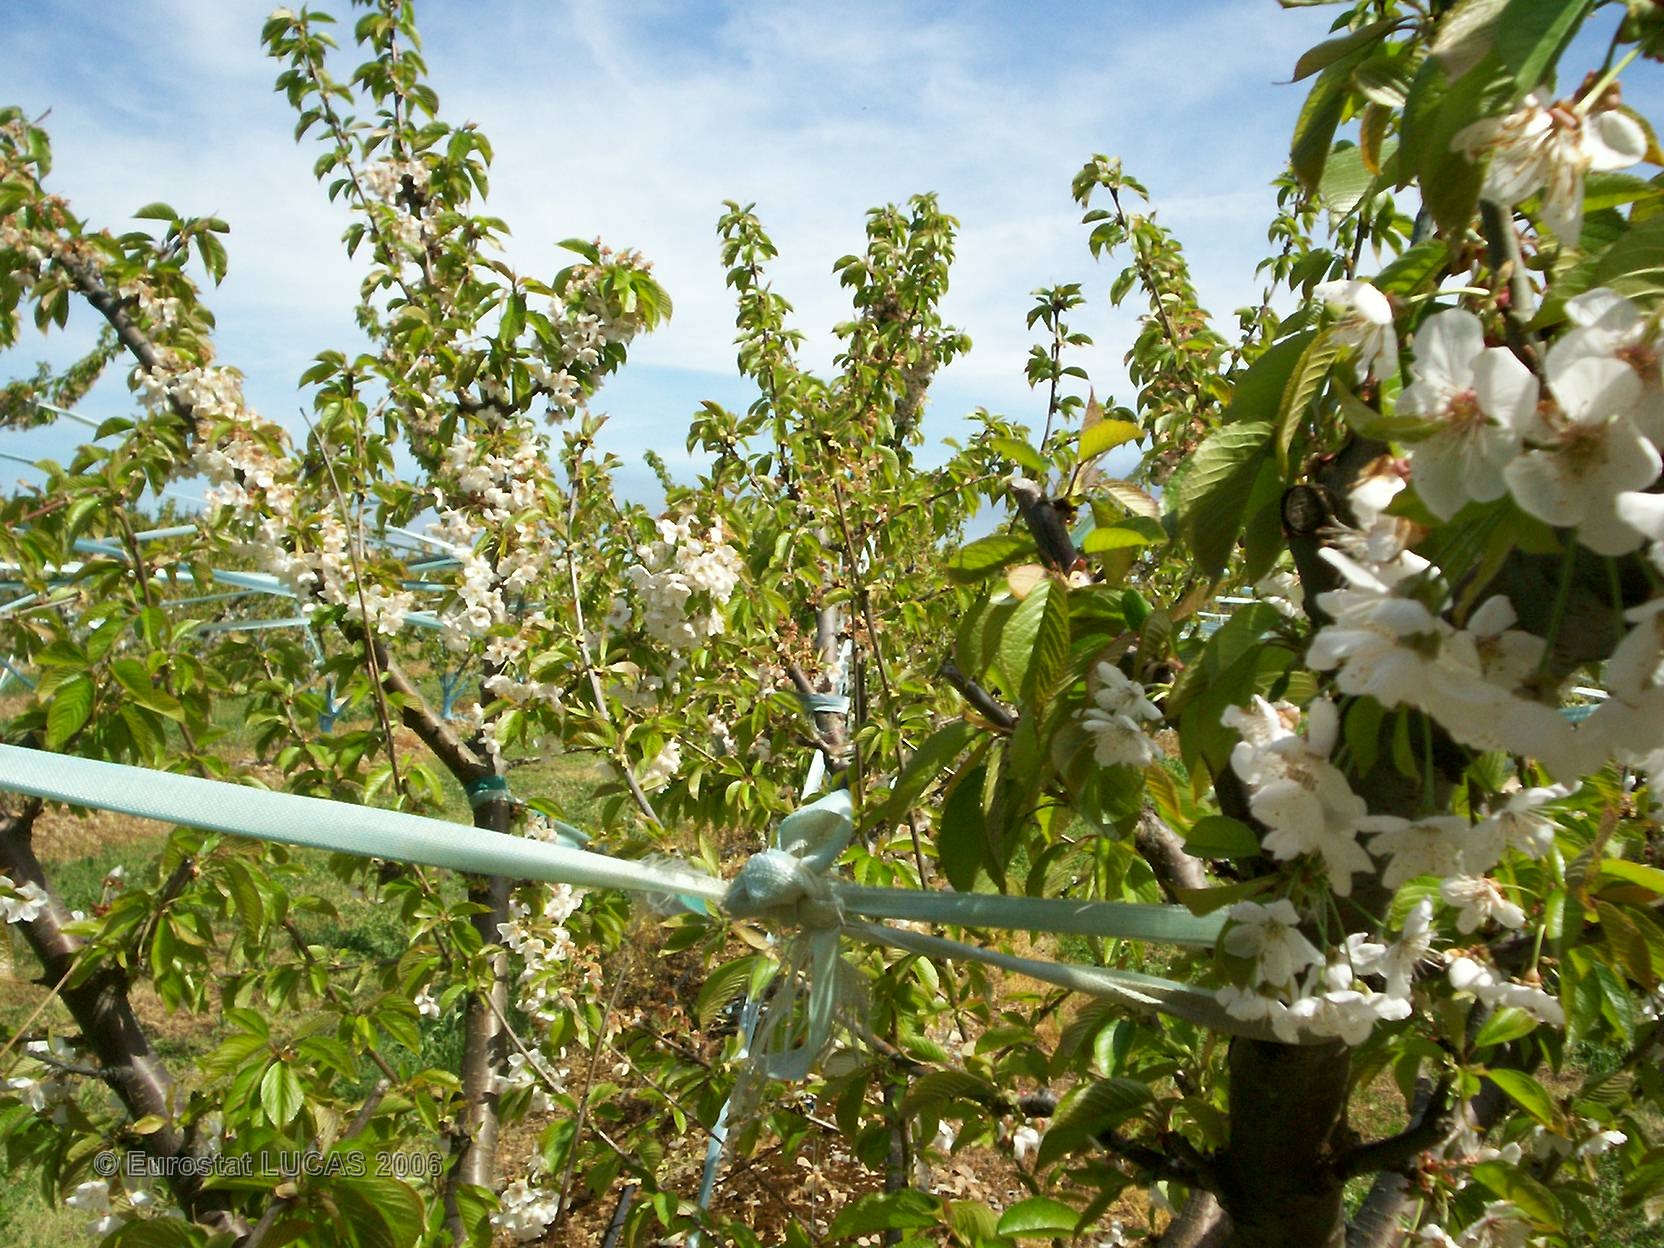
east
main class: Cropland
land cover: Cherry fruit
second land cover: Grassland with sparse tree/shrub cover
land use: Agriculture (excluding fallow land and kitchen gardens)
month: April
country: FR
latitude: 43.6872
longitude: 4.9850
